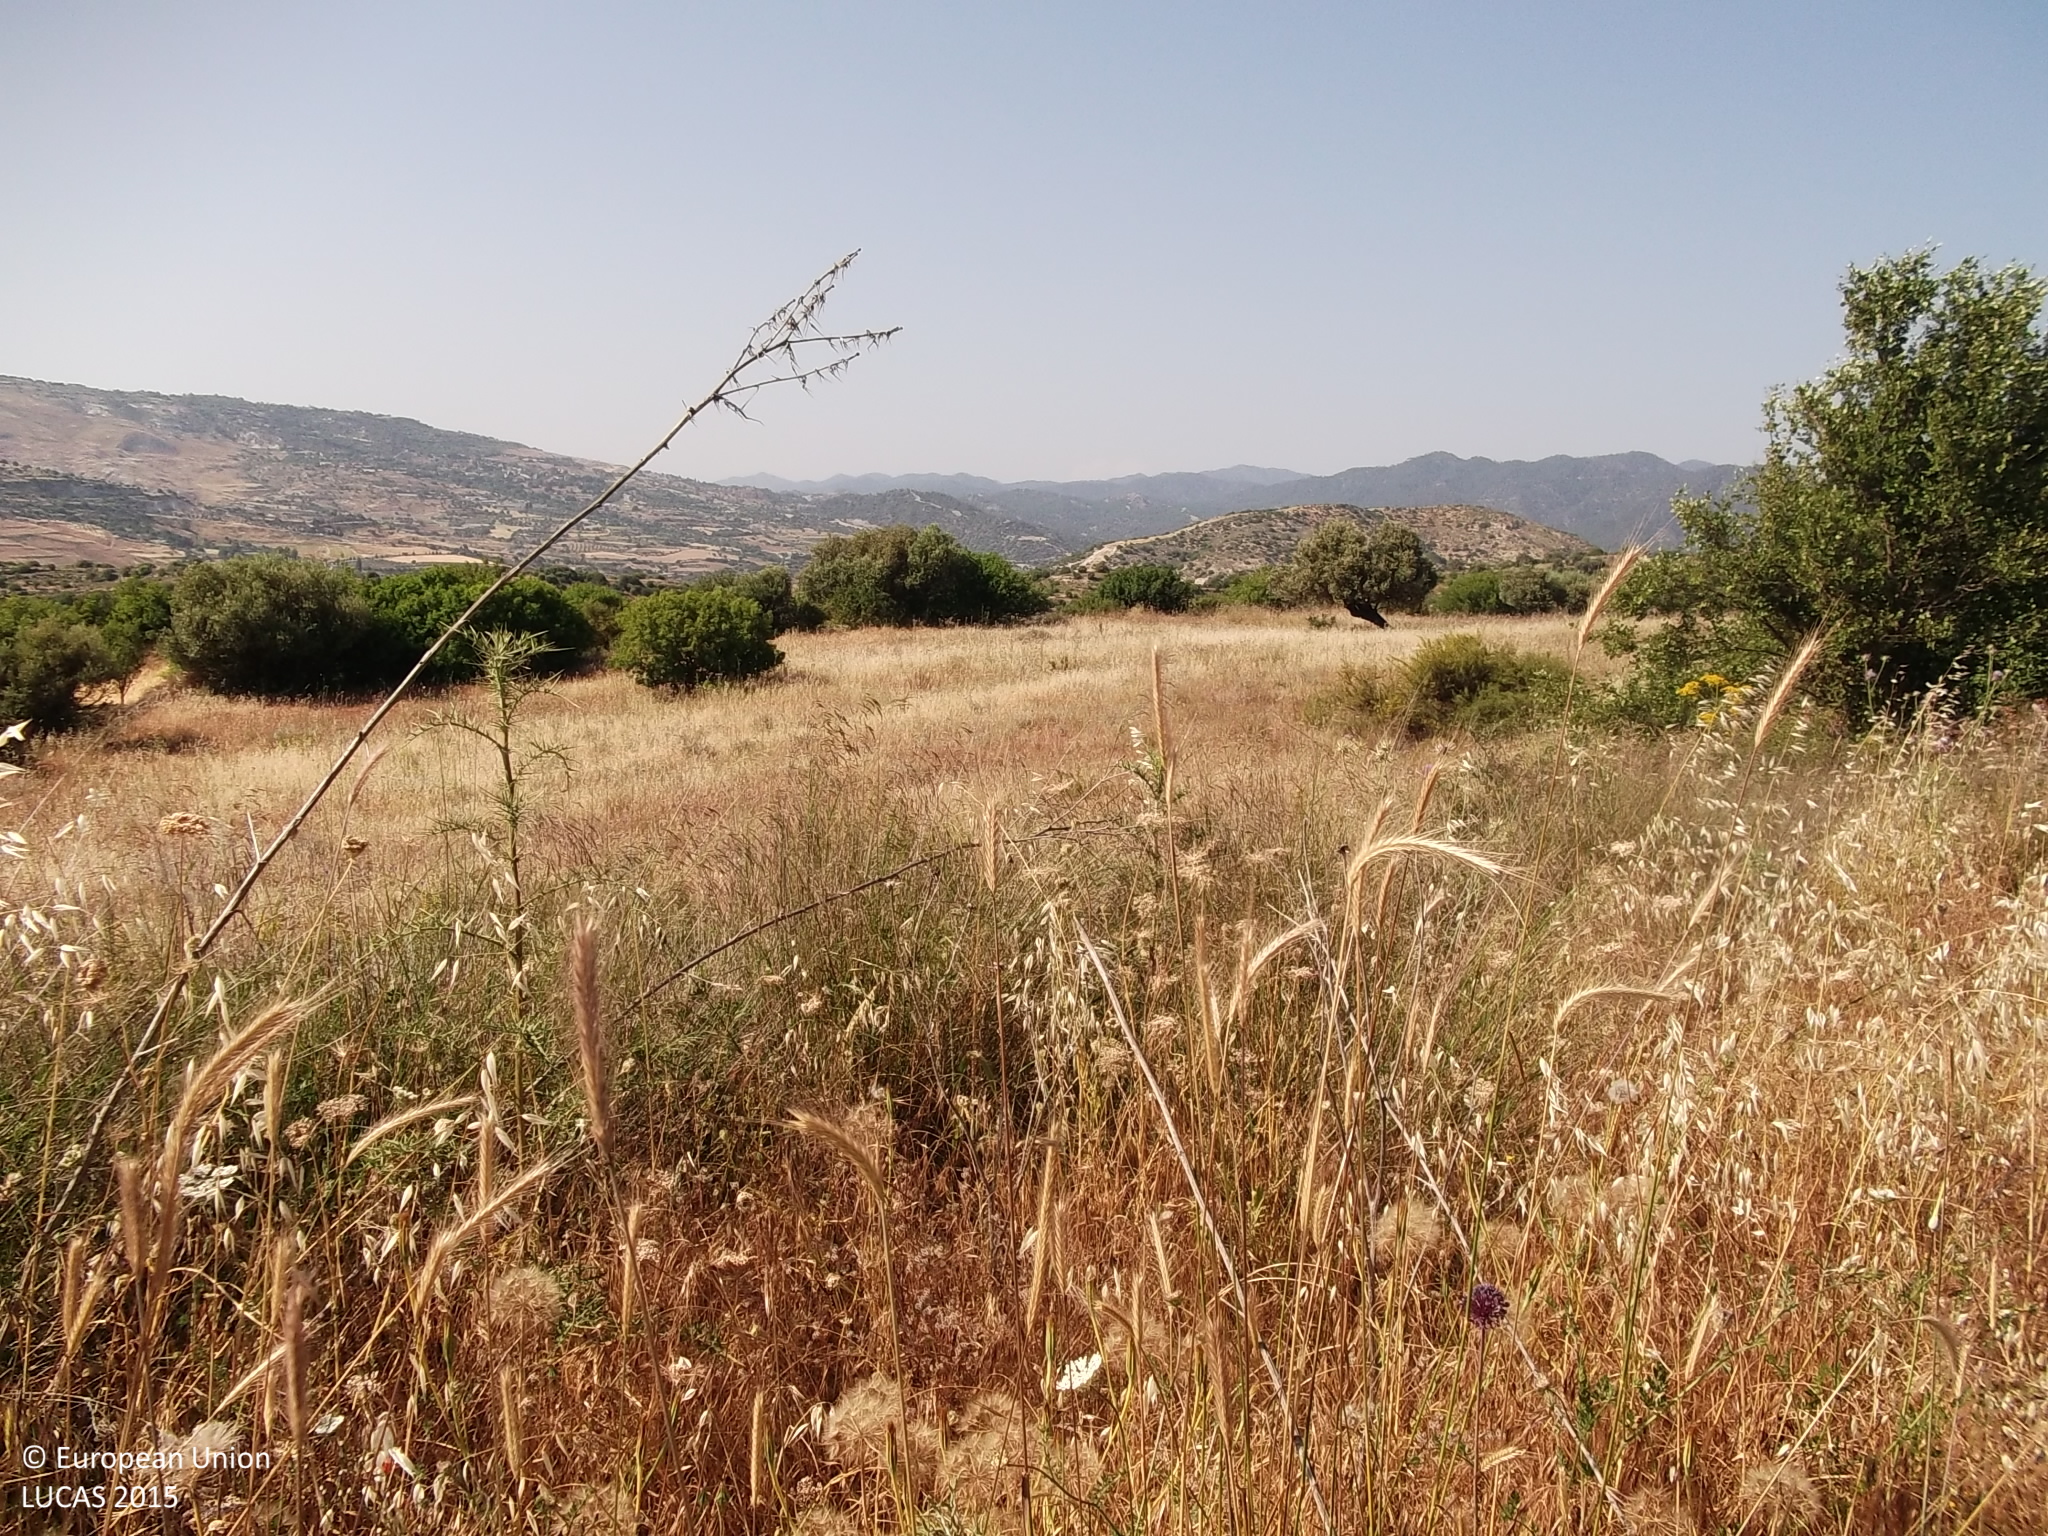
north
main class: Grassland
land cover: Grassland with sparse tree/shrub cover
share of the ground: > 75 %
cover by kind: herbaceous plants 90 %, broadleaved forest trees 5 %, shrubs 5 %
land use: Semi-natural and natural areas not in use
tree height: < 5 m
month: May
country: CY
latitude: 34.8835
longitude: 32.5724
